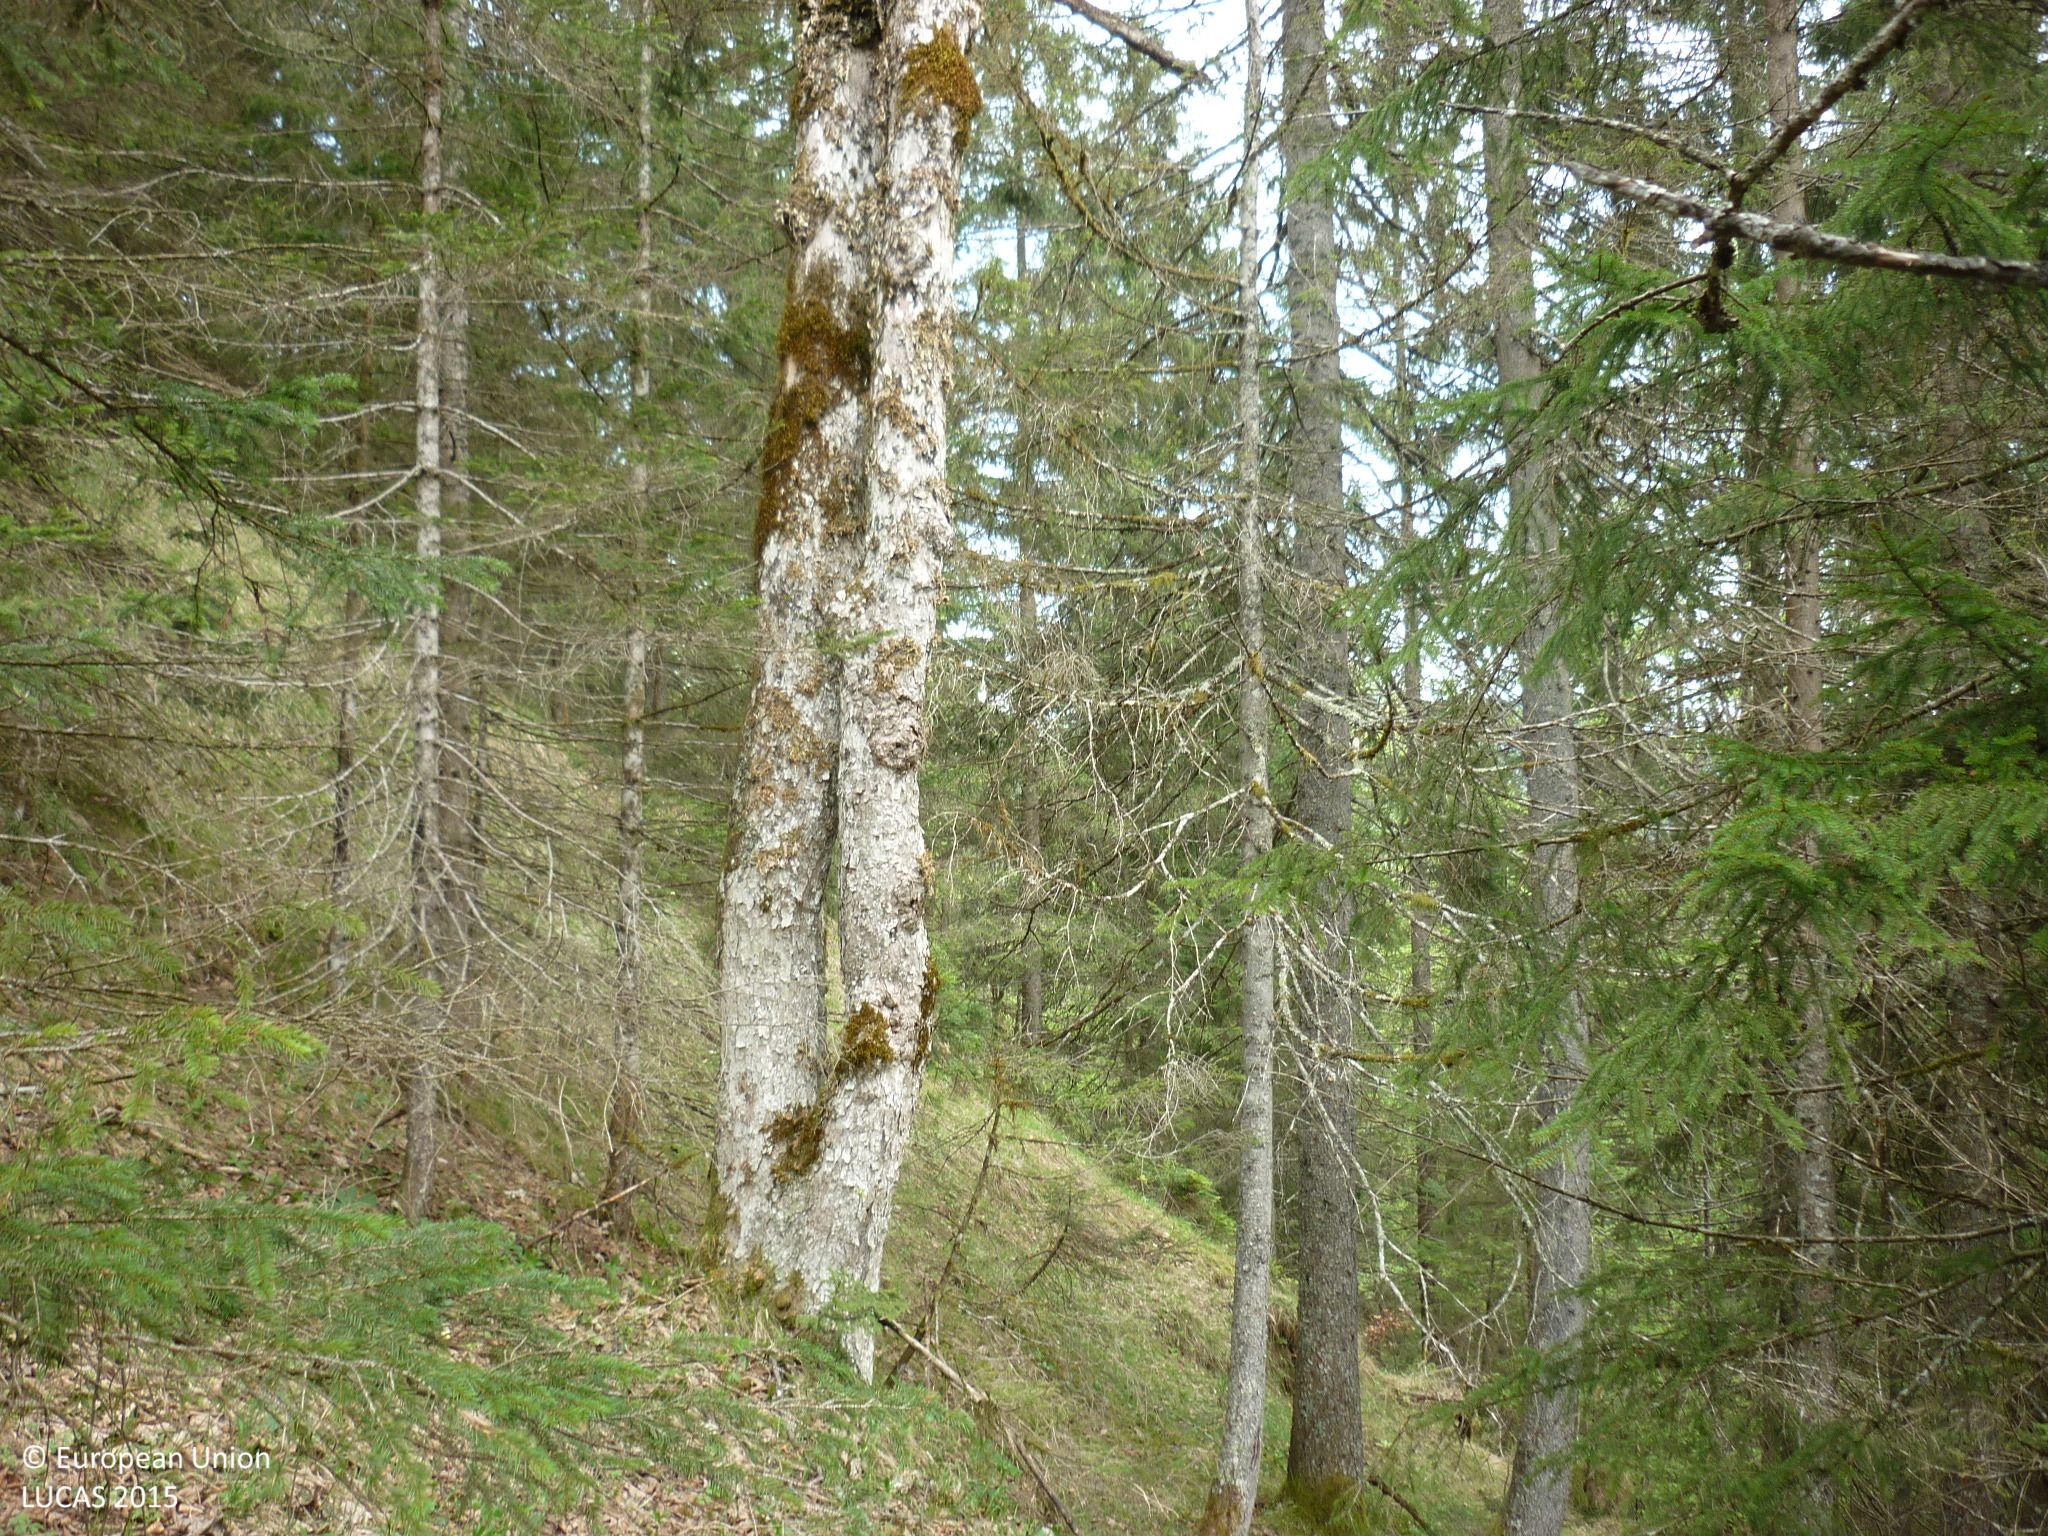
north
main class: Woodland
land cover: Spruce dominated mixed woodland
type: mountainous beech forest
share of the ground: > 75 %
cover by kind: coniferous forest trees 70 %, broadleaved forest trees 25 %, herbaceous plants 5 %
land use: Forestry
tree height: > 5 m
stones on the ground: < 10 %
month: May
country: AT
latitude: 47.6956
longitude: 14.9970
